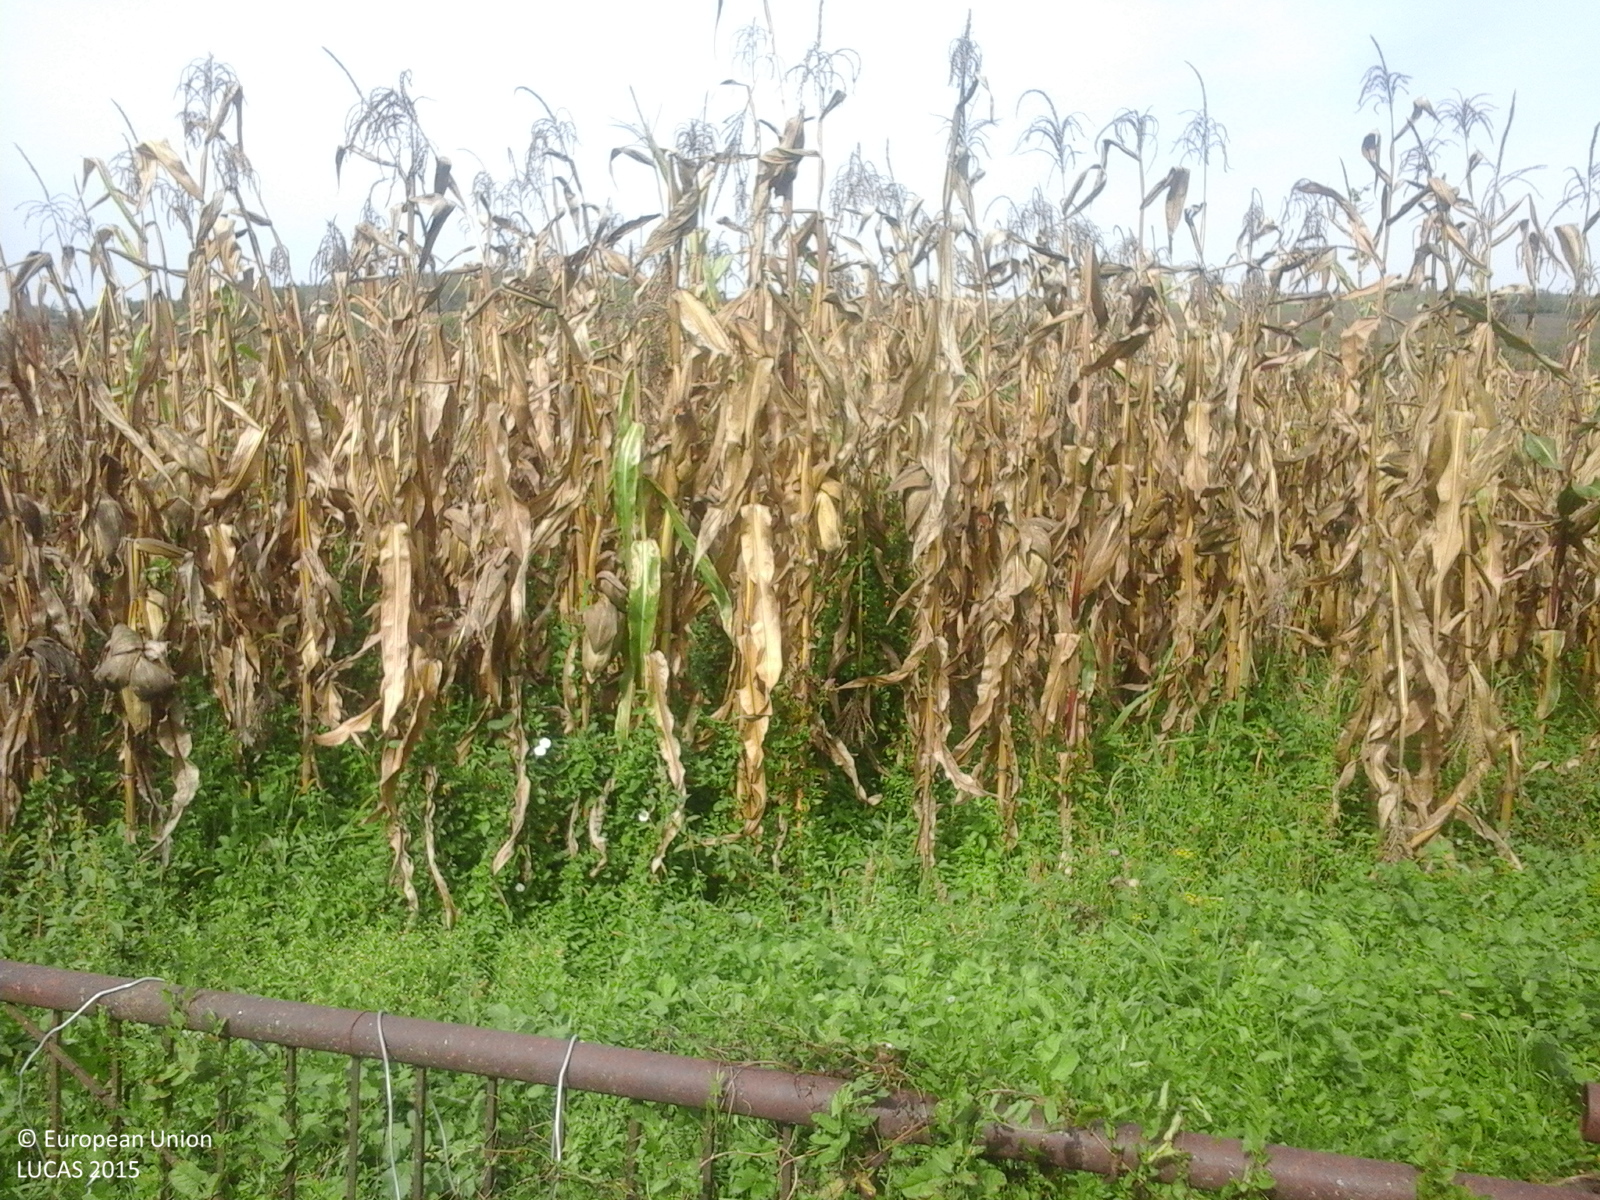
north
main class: Grassland
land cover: Spontaneously vegetated surfaces
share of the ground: > 75 %
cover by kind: herbaceous plants 100 %
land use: Fallow land
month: September
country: RO
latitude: 46.9294
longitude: 23.6670
